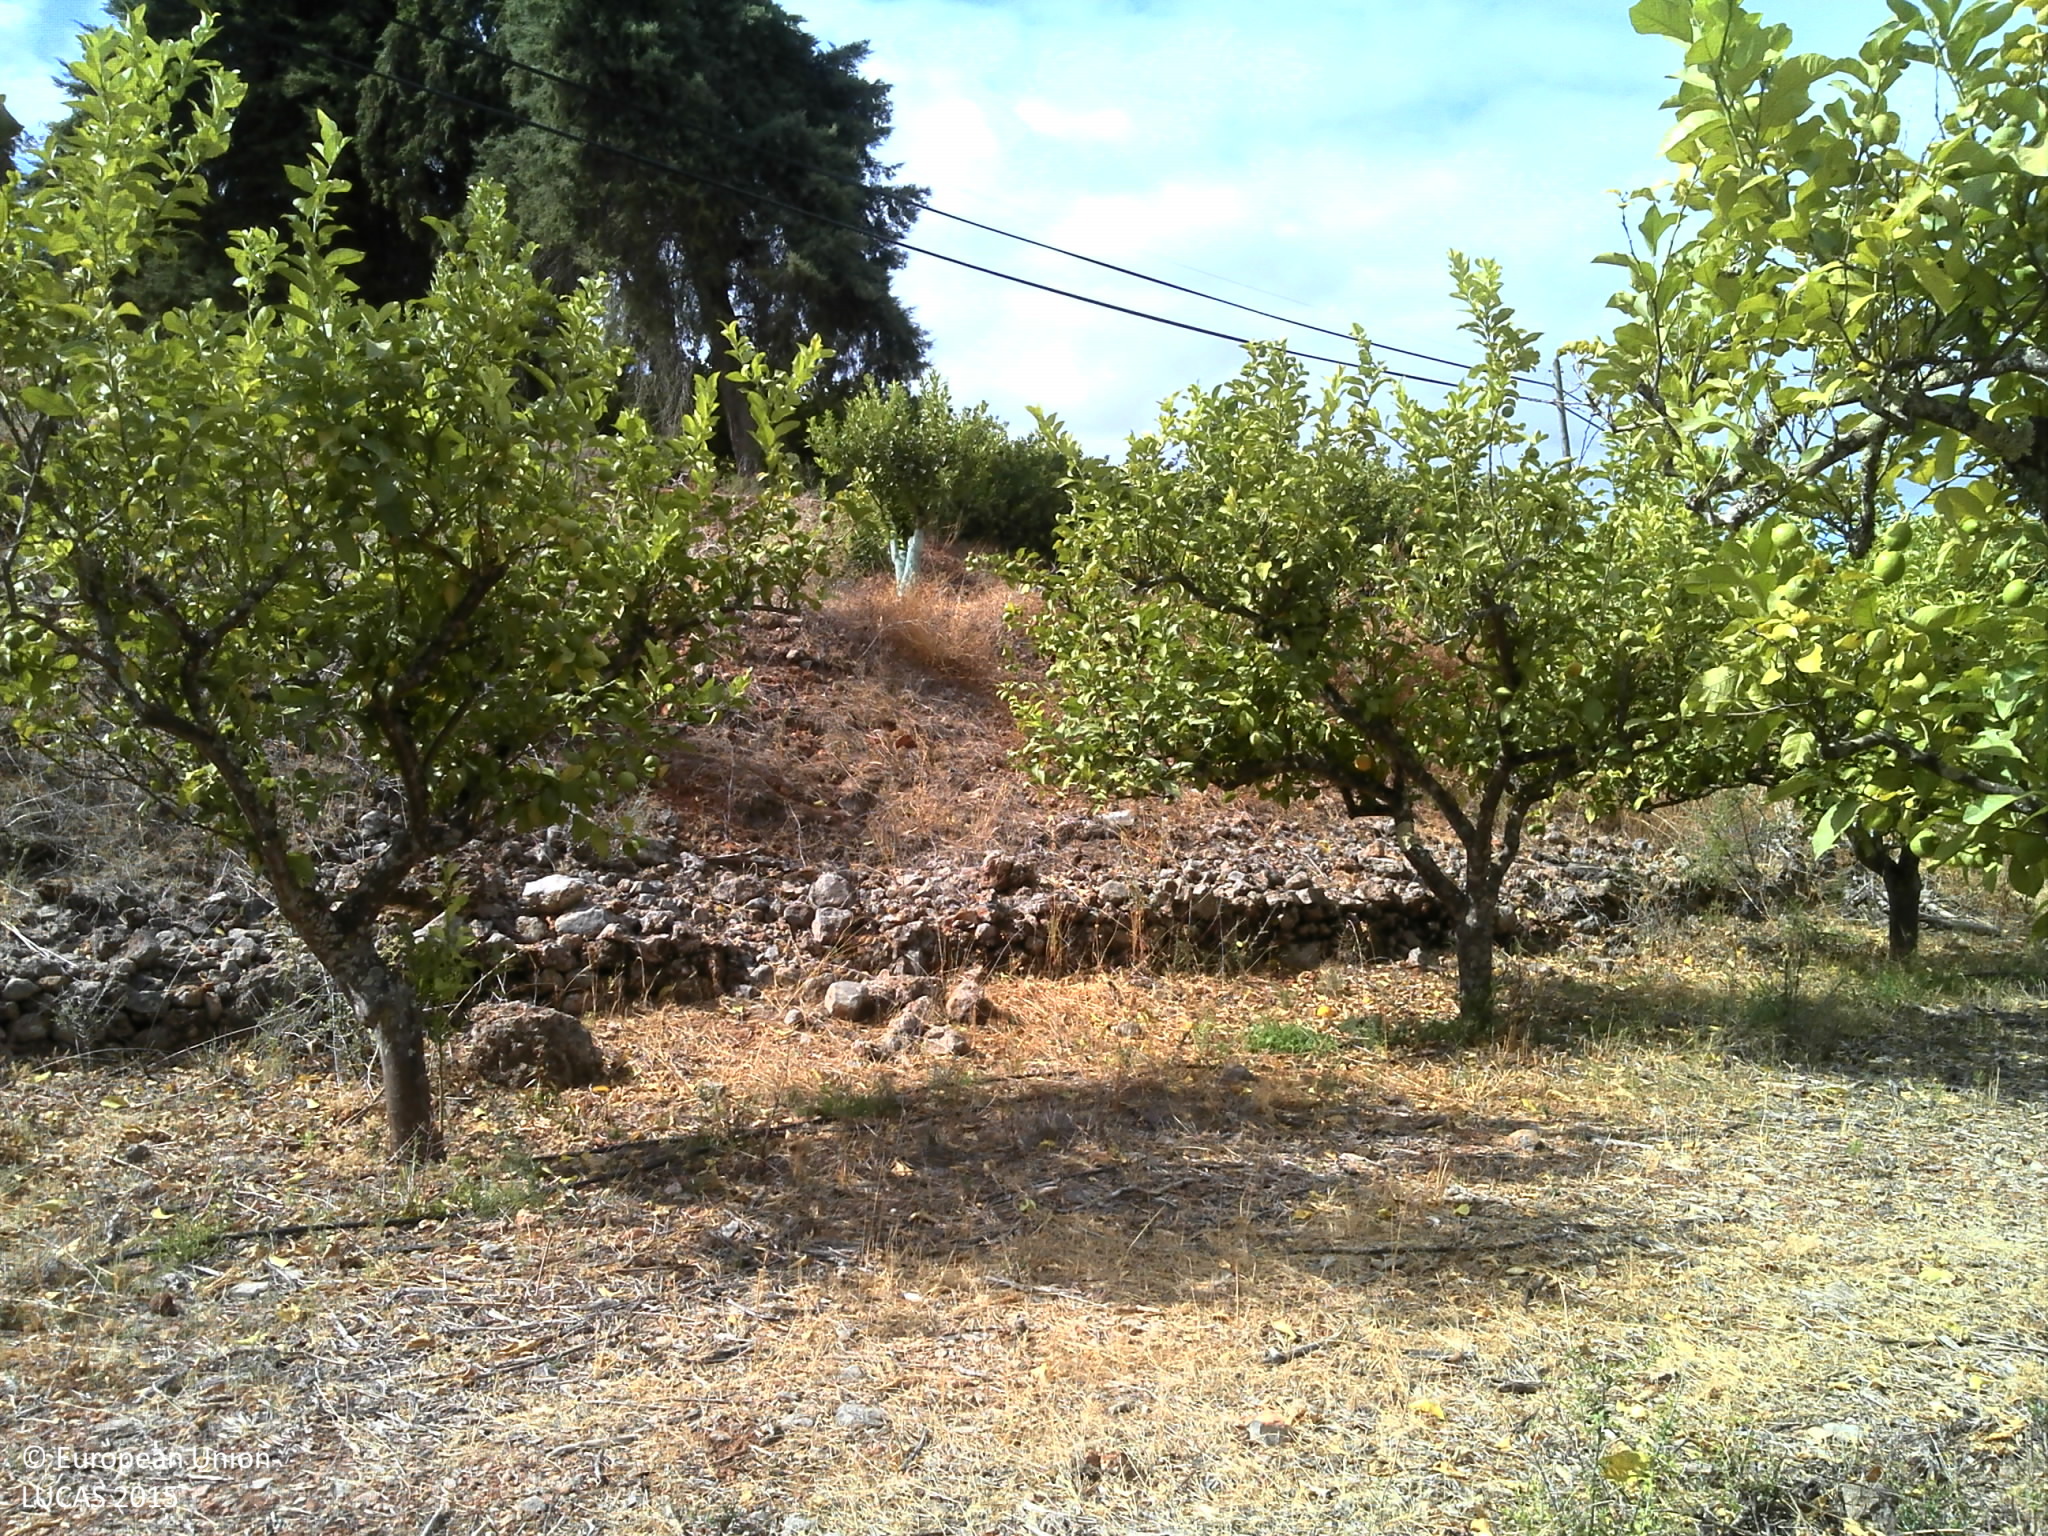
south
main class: Cropland
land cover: Other citrus fruit
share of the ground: 25 - 50 %
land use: Agriculture (excluding fallow land and kitchen gardens)
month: September
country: PT
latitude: 37.1959
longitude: -8.3981
